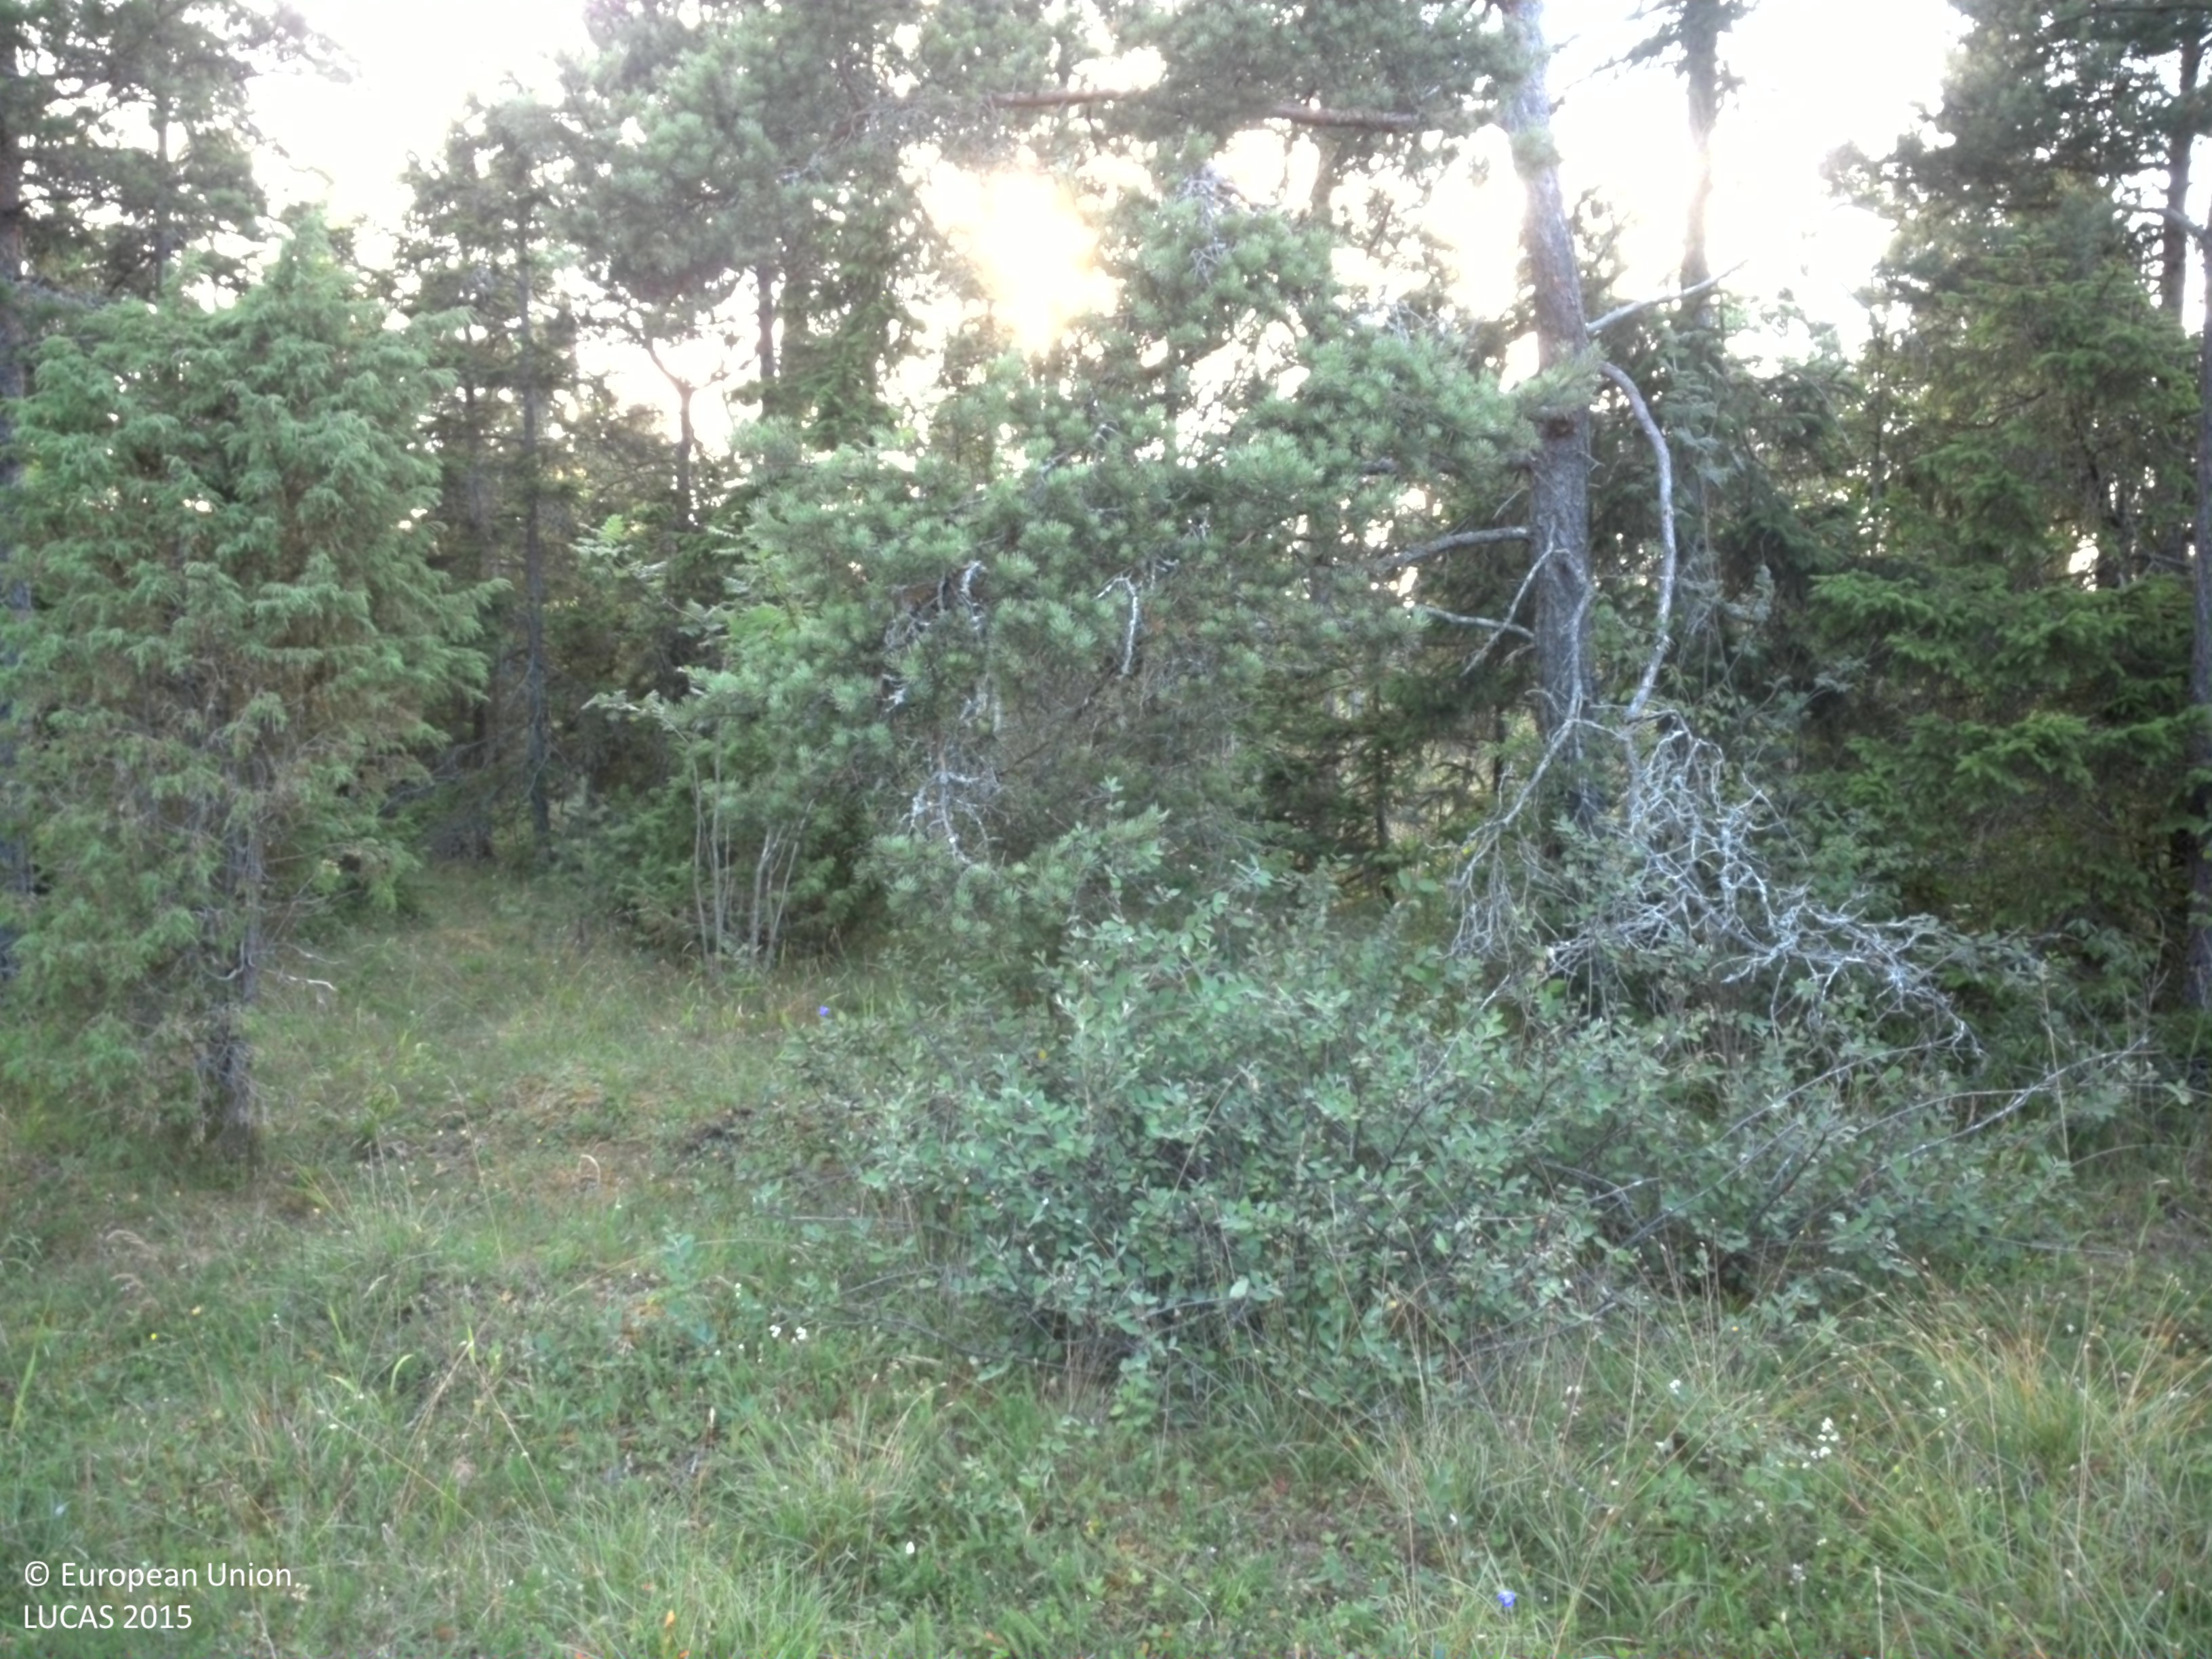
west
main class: Grassland
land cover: Grassland with sparse tree/shrub cover
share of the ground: > 75 %
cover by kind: herbaceous plants 90 %, coniferous forest trees 5 %, shrubs 5 %
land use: Semi-natural and natural areas not in use
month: July
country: SE
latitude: 57.5893
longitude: 18.7589
